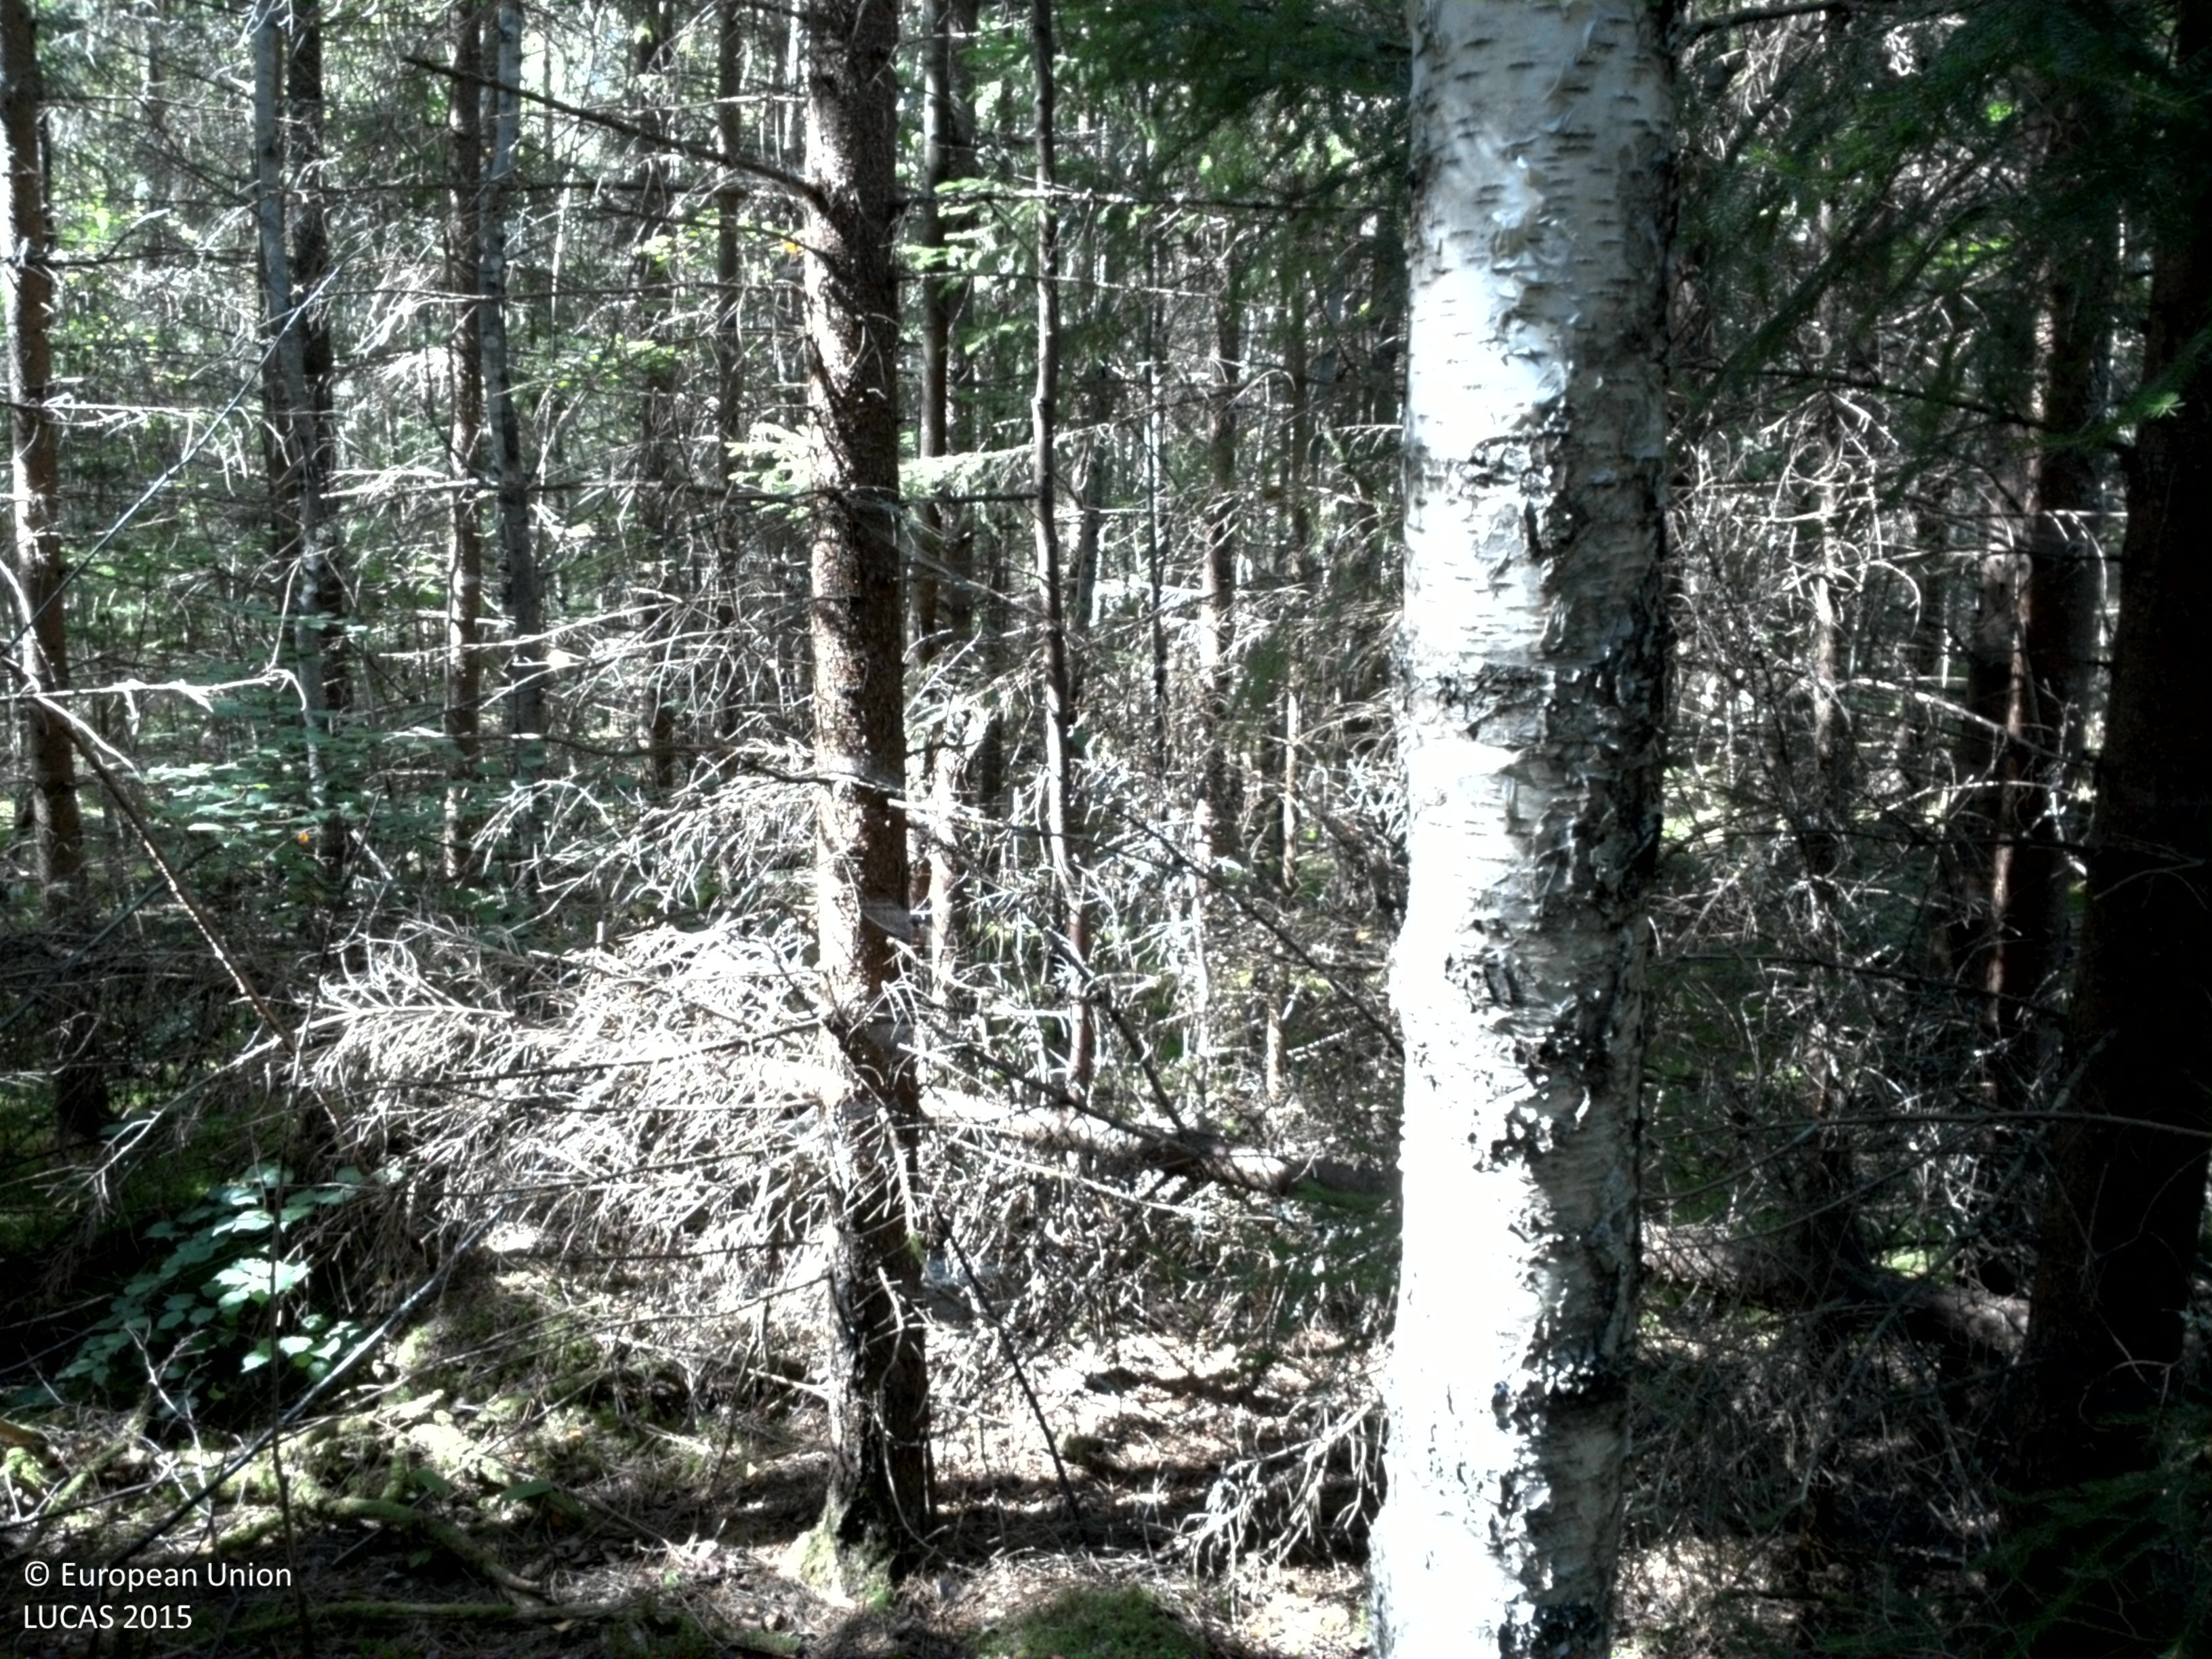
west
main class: Woodland
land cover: Spruce dominated coniferous woodland
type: boreal forest
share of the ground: > 75 %
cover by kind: coniferous forest trees 95 %, lichens and mosses 5 %
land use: Forestry
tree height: > 5 m
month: August
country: SE
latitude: 59.7013
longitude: 17.6541
